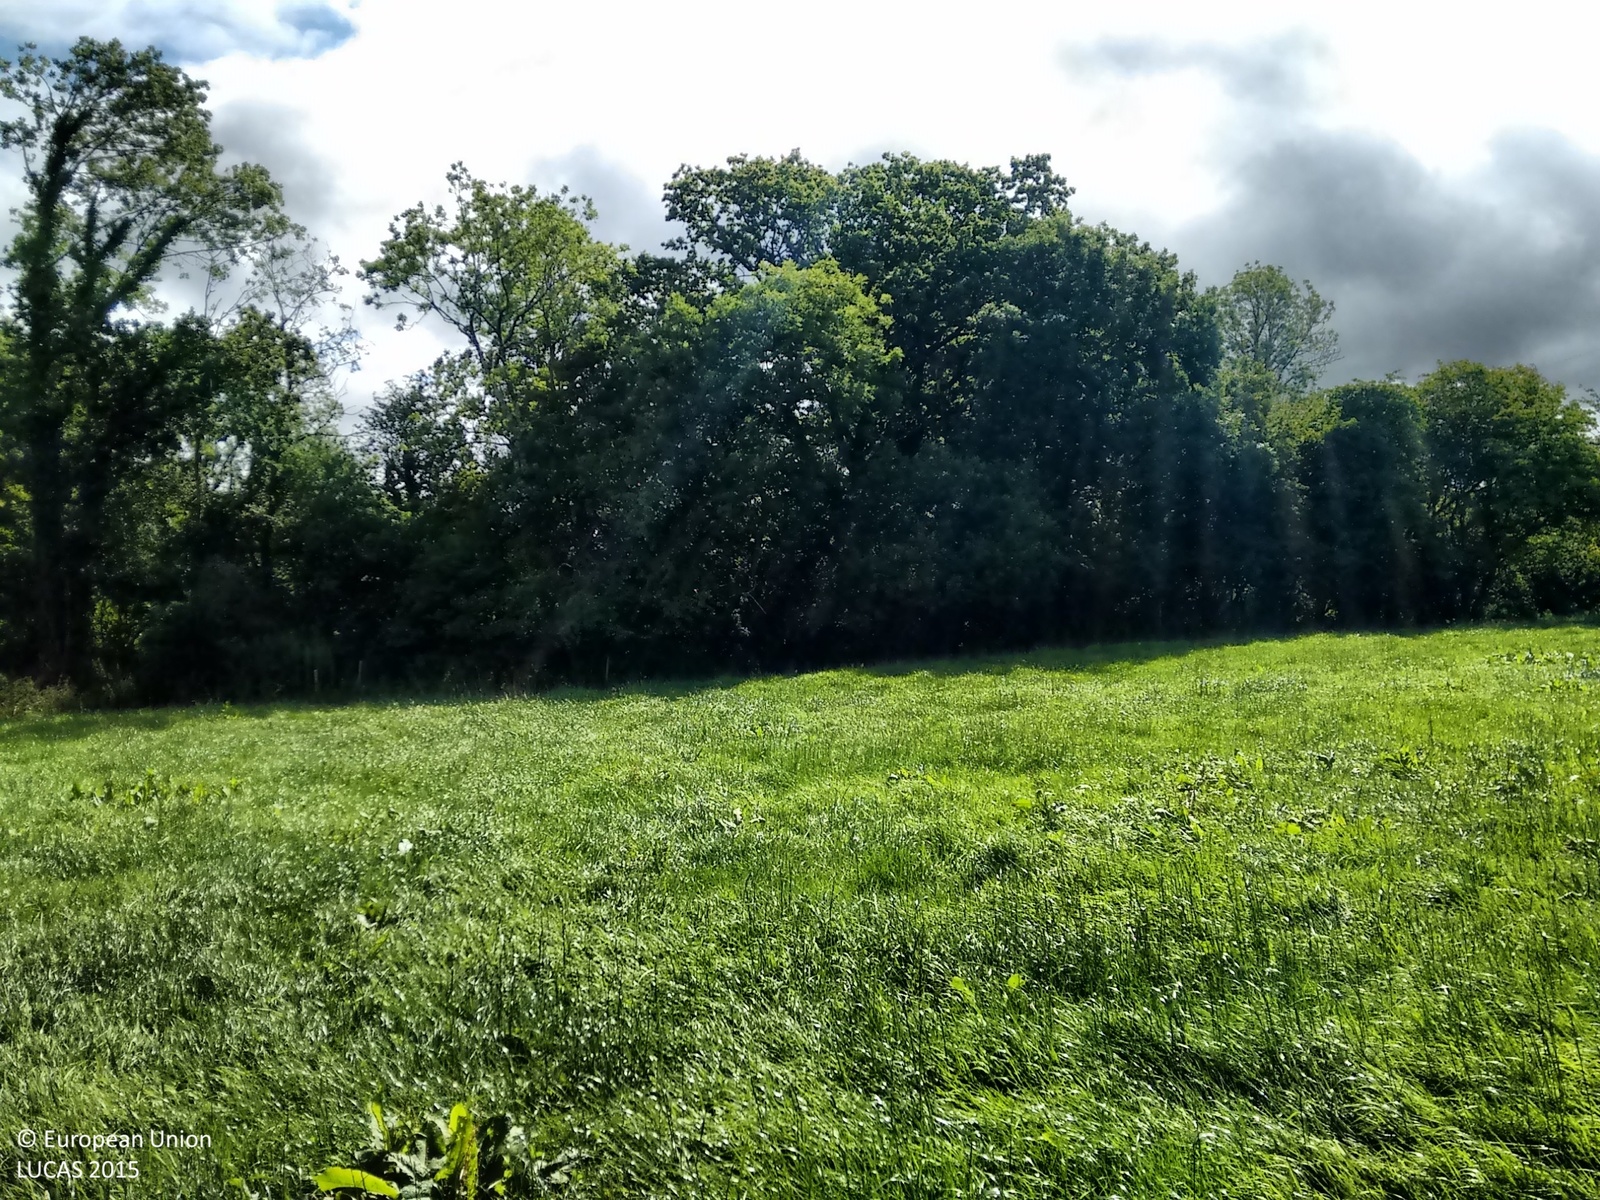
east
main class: Grassland
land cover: Grassland without tree/shrub cover
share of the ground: > 75 %
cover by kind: herbaceous plants 100 %
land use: Agriculture (excluding fallow land and kitchen gardens)
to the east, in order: Grassland without tree/shrub cover; Fences; Broadleaved woodland; Ditches and canals; Broadleaved woodland; Artificial constructions in urban areas; Grassland without tree/shrub cover; Fences; Abandoned hedges; Grassland without tree/shrub cover
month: July
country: IE
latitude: 52.7168
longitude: -7.4021
